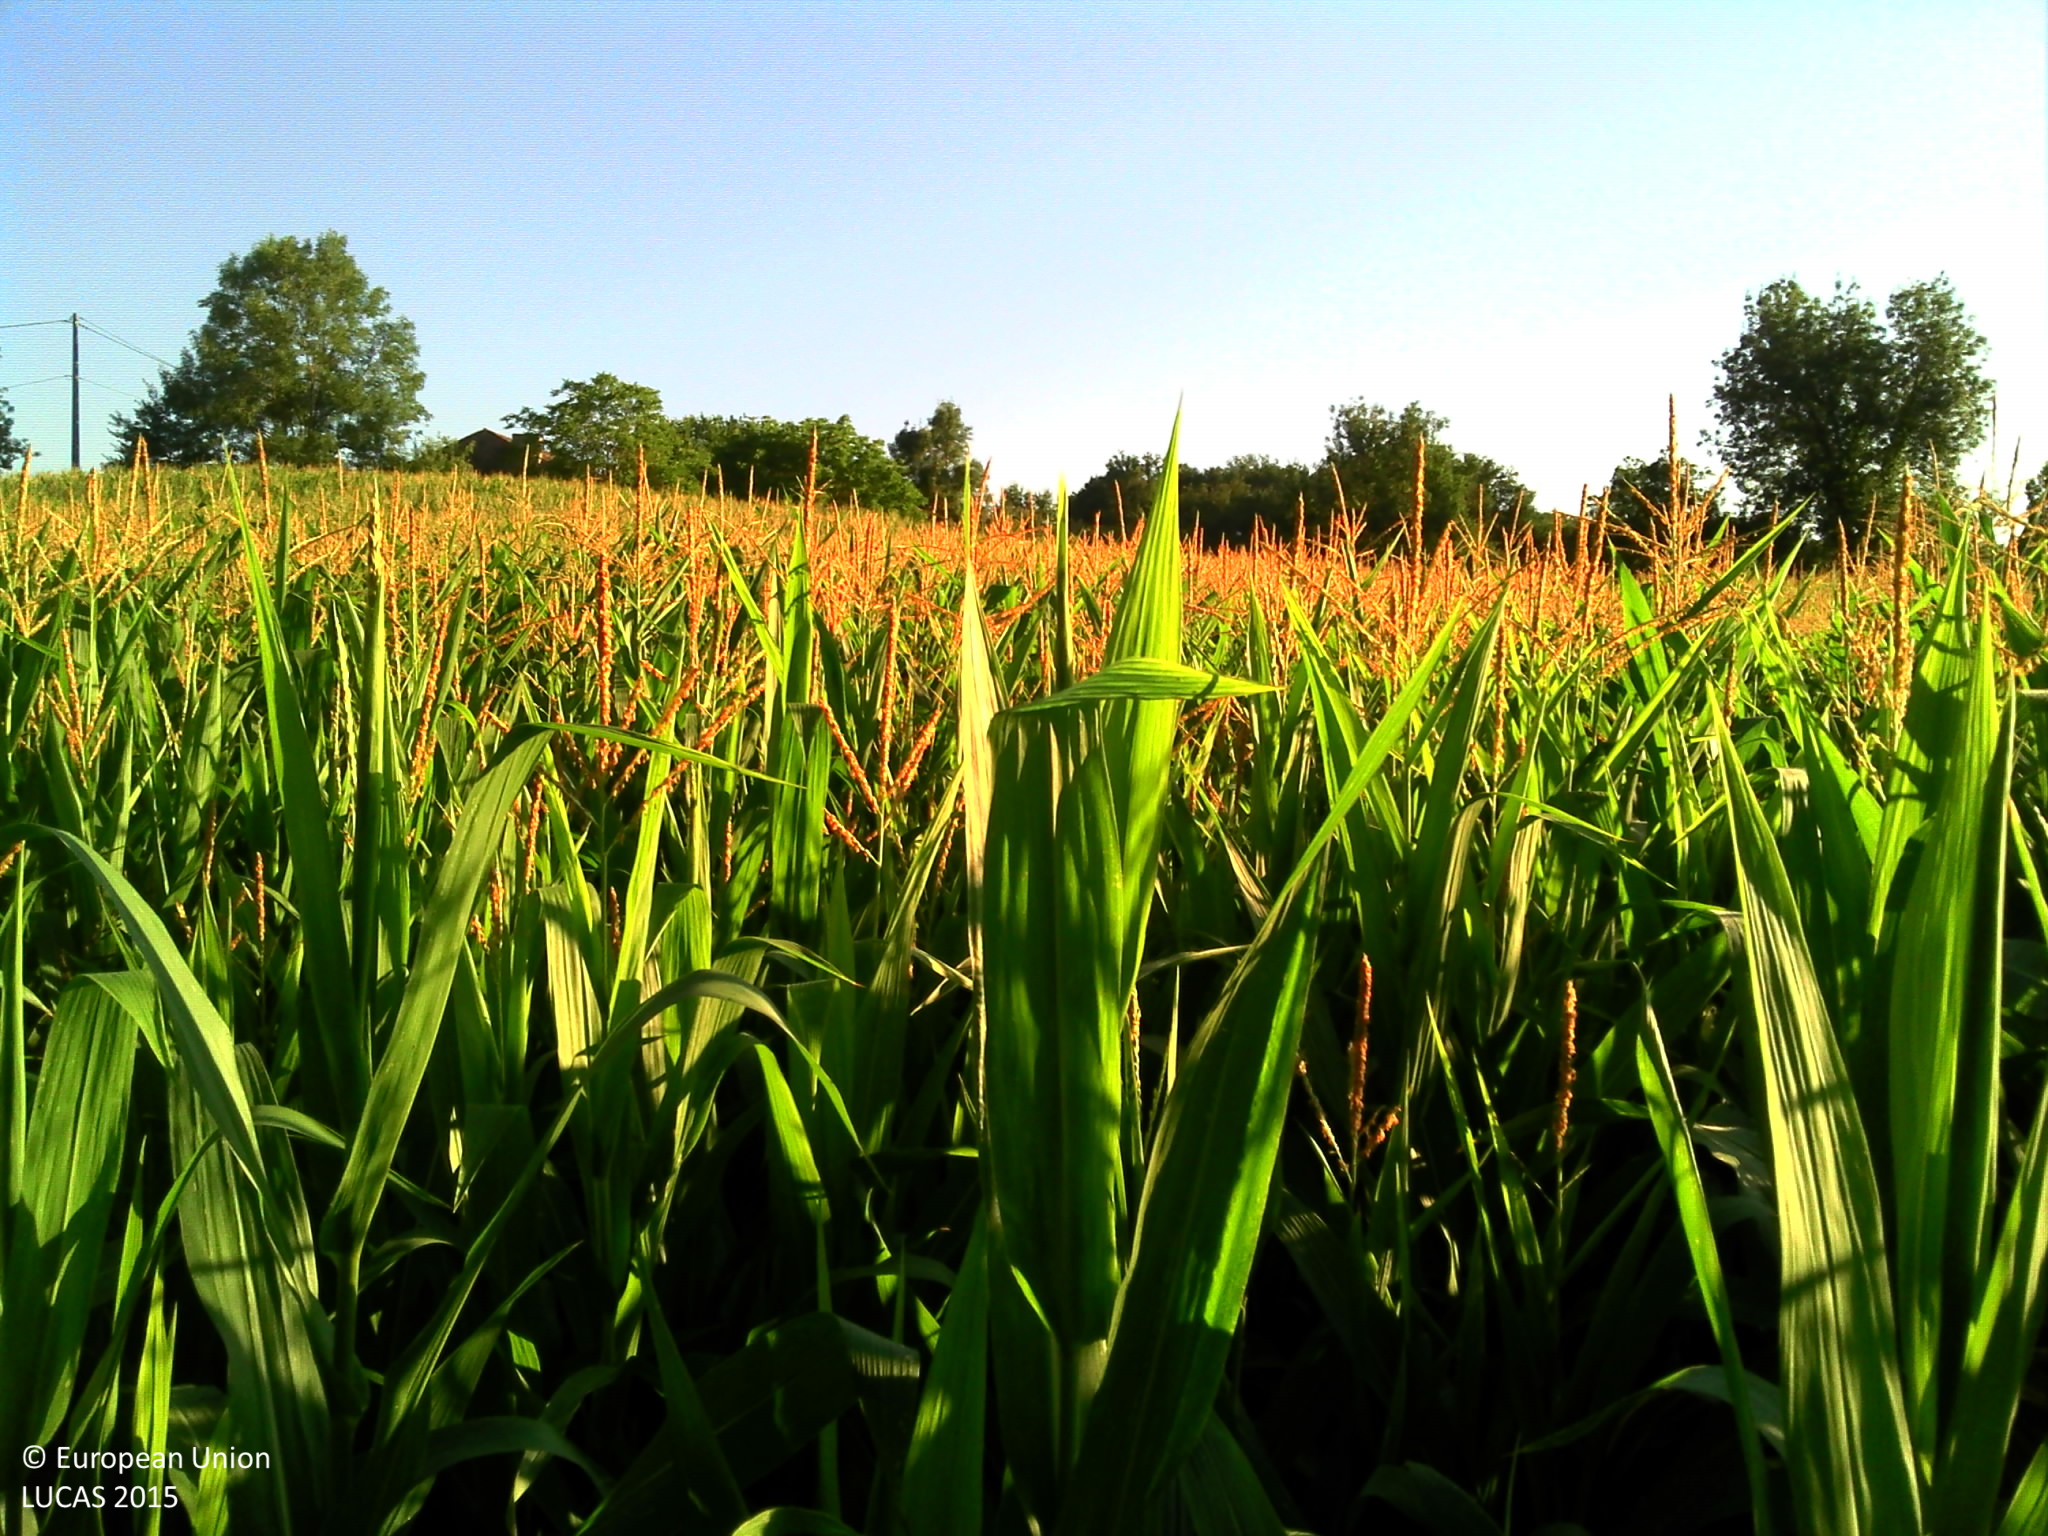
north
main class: Cropland
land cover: Maize
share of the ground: > 75 %
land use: Agriculture (excluding fallow land and kitchen gardens)
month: July
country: FR
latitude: 44.5795
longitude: 0.6353
